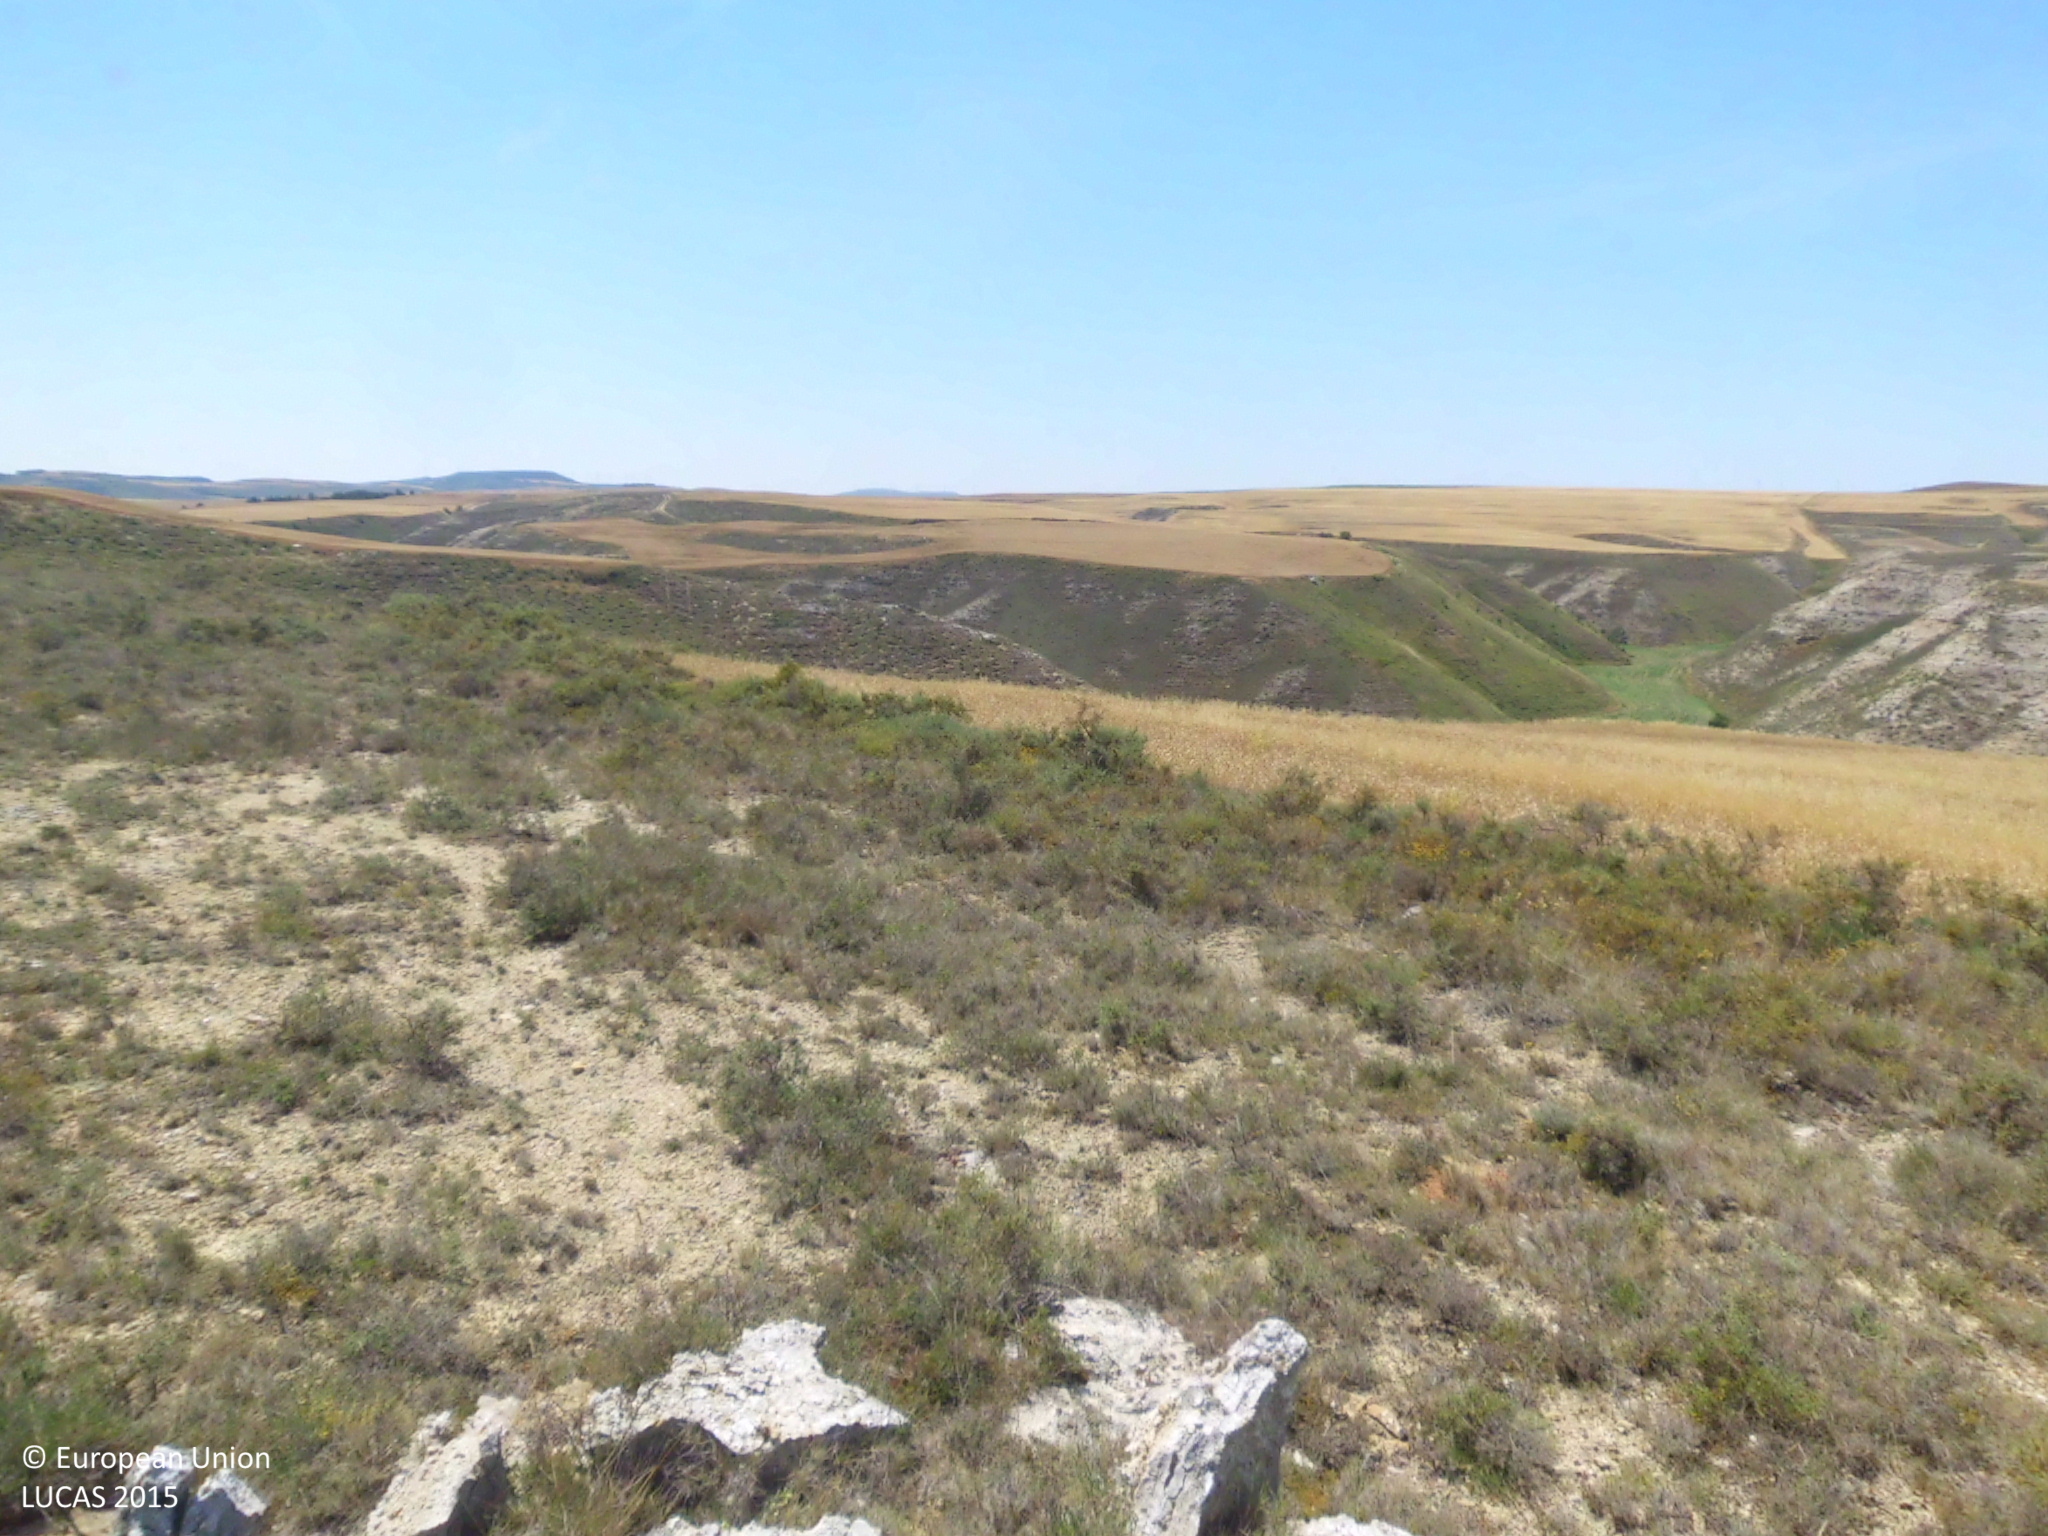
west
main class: Shrubland
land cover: Shrubland without tree cover
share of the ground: 50 - 75 %
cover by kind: shrubs 50 %, unconsolidated bare surface 35 %, herbaceous plants 15 %
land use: Semi-natural and natural areas not in use
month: July
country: ES
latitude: 42.4848
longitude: -3.3045
